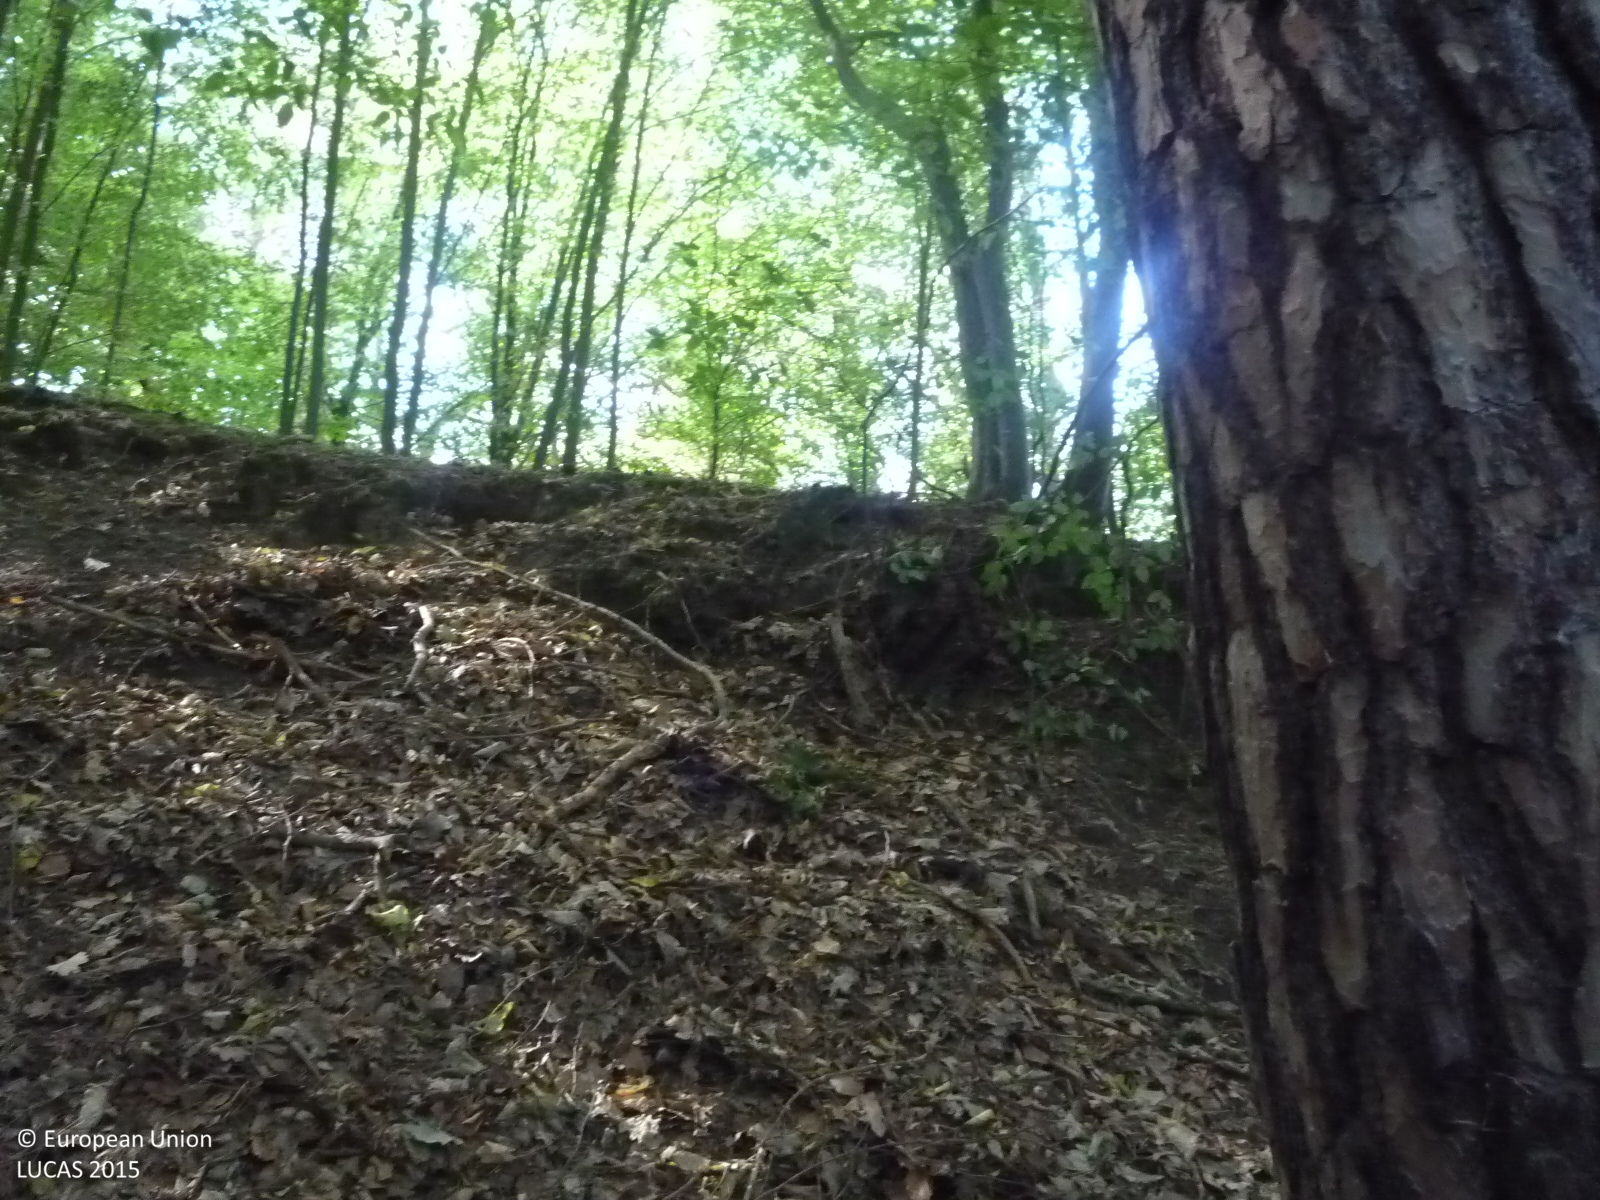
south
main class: Woodland
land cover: Pine dominated mixed woodland
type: hemiboreal forest and nemoral coniferous forest and mixed broadleaved-coniferous forest
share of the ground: > 75 %
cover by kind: broadleaved forest trees 60 %, coniferous forest trees 40 %
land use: Forestry
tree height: > 5 m
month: July
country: CZ
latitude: 50.5254
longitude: 14.5581
